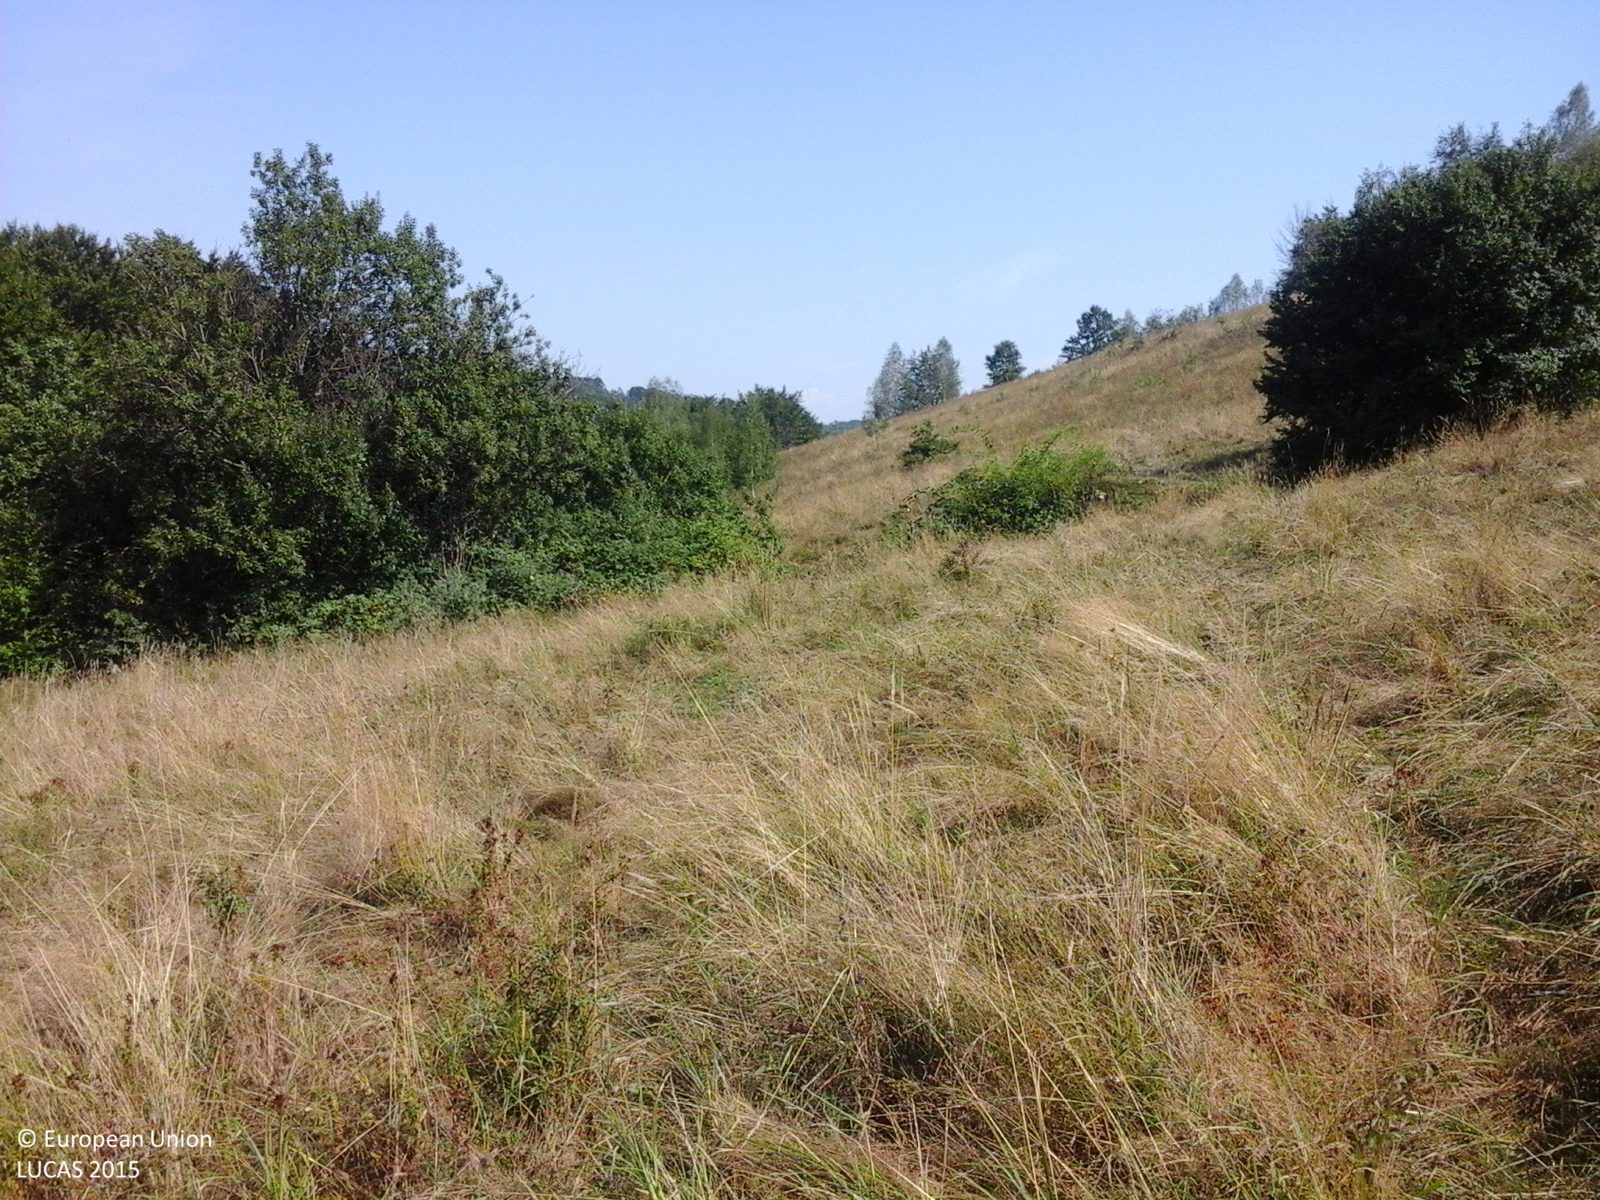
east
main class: Grassland
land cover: Grassland without tree/shrub cover
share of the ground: > 75 %
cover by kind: herbaceous plants 100 %
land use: Agriculture (excluding fallow land and kitchen gardens)
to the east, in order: Grassland without tree/shrub cover; Broadleaved woodland; Rivers and streams; Broadleaved woodland; Rivers and streams; Broadleaved woodland
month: August
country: RO
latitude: 45.8594
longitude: 22.7378
